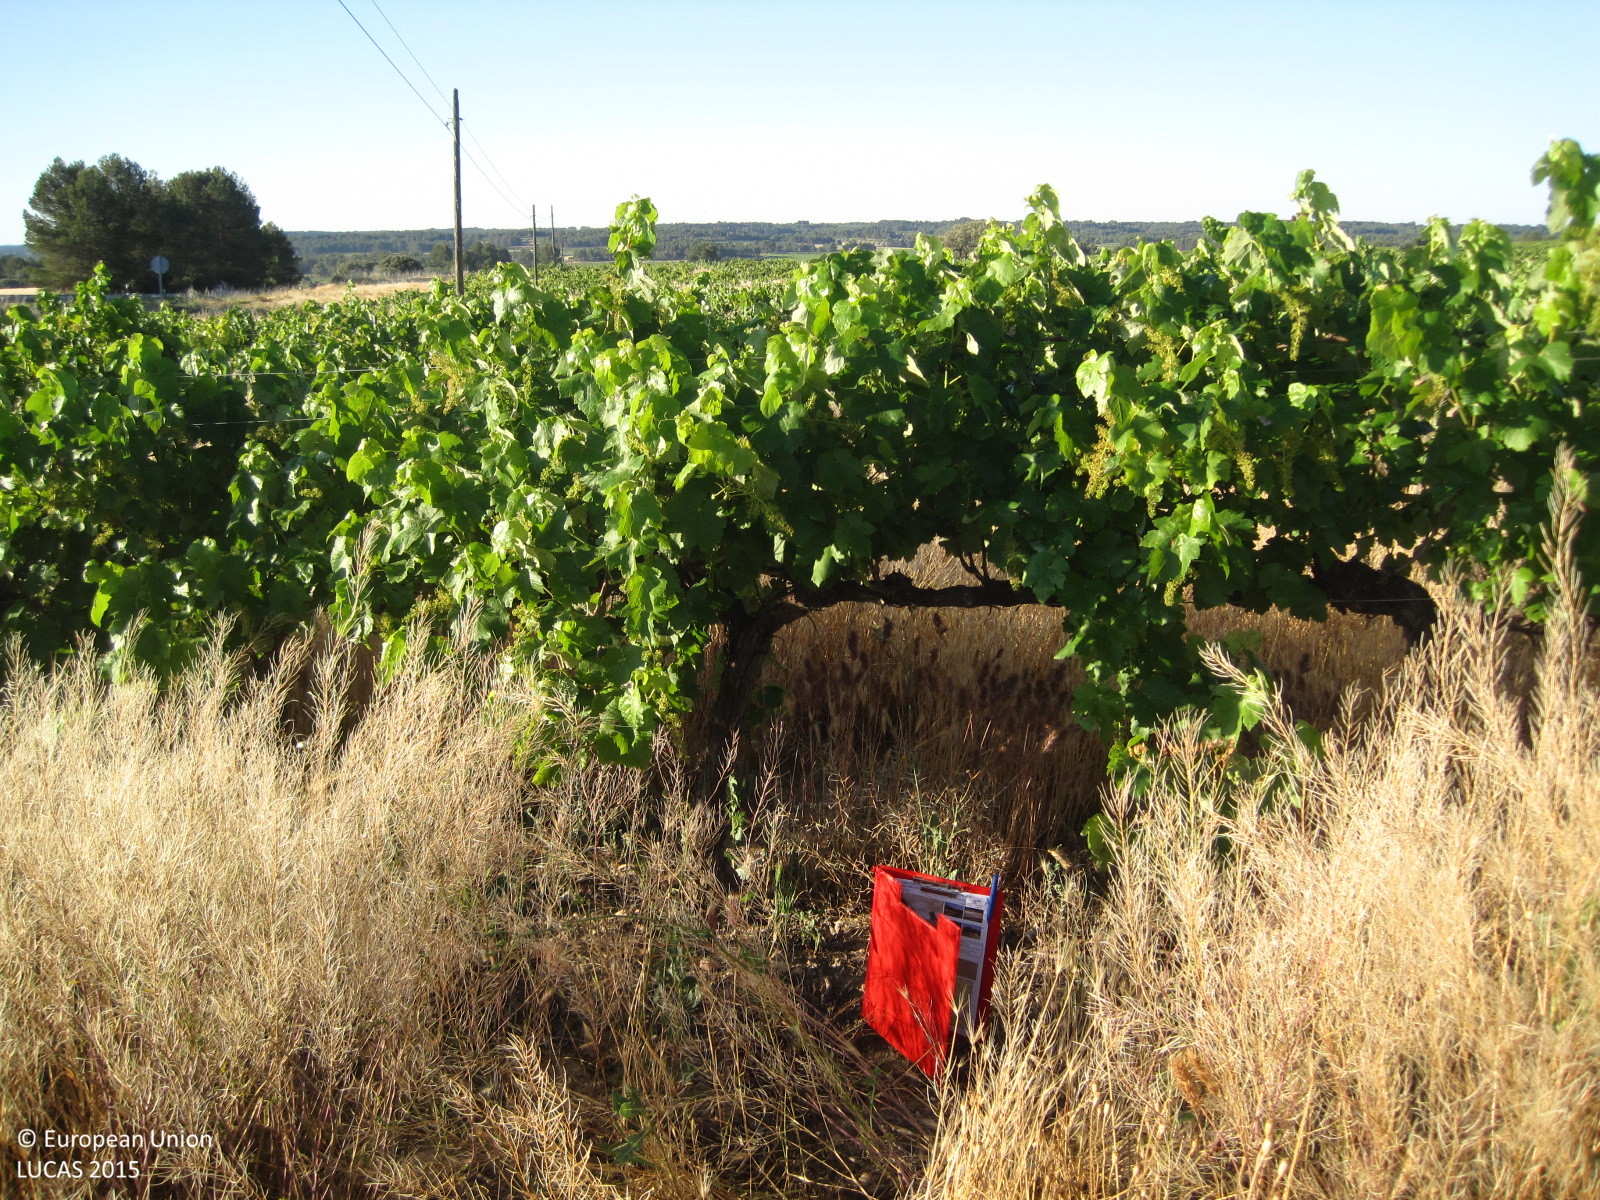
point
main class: Cropland
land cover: Vineyards
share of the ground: 10 - 25 %
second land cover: Spontaneously vegetated surfaces
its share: > 75 %
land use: Agriculture (excluding fallow land and kitchen gardens)
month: June
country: ES
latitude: 39.3609
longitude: -1.1067
